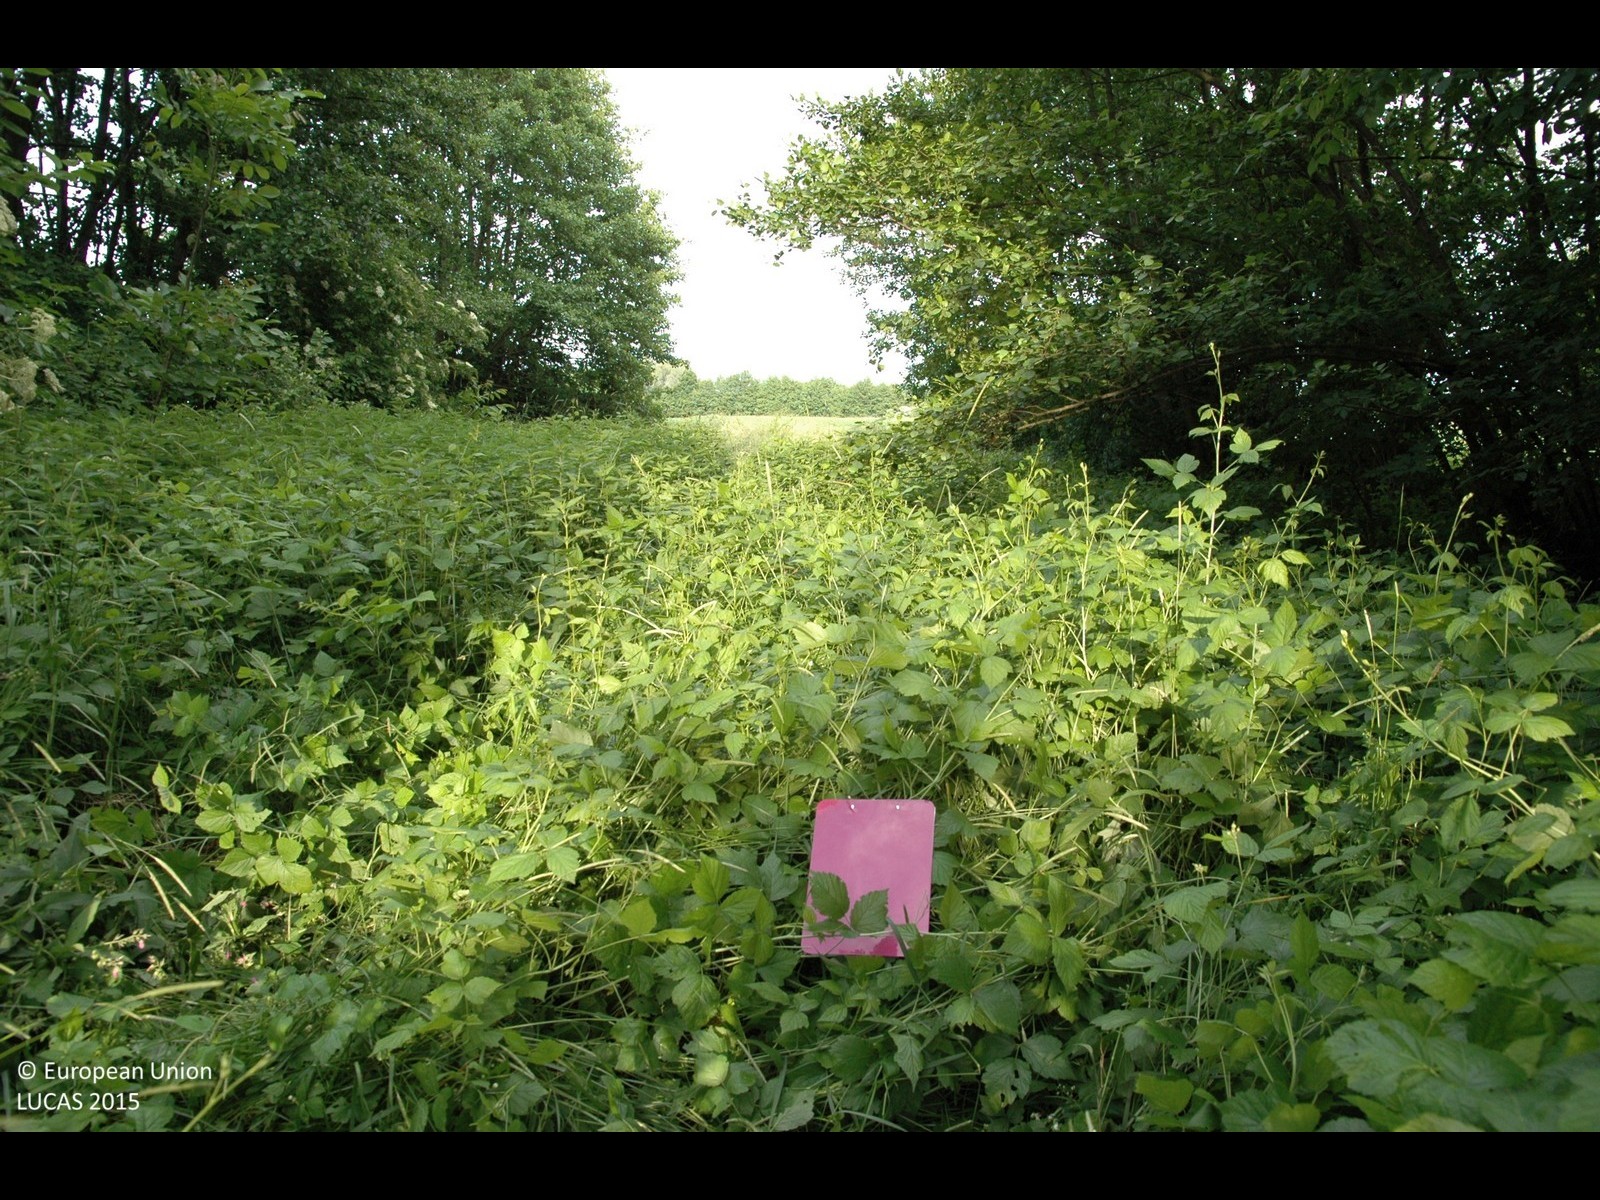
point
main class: Woodland
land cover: Broadleaved woodland
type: mesophytic deciduous forest
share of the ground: > 75 %
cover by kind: shrubs 50 %, broadleaved forest trees 40 %, herbaceous plants 10 %
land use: Forestry
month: May
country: HR
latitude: 46.3599
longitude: 16.6687
